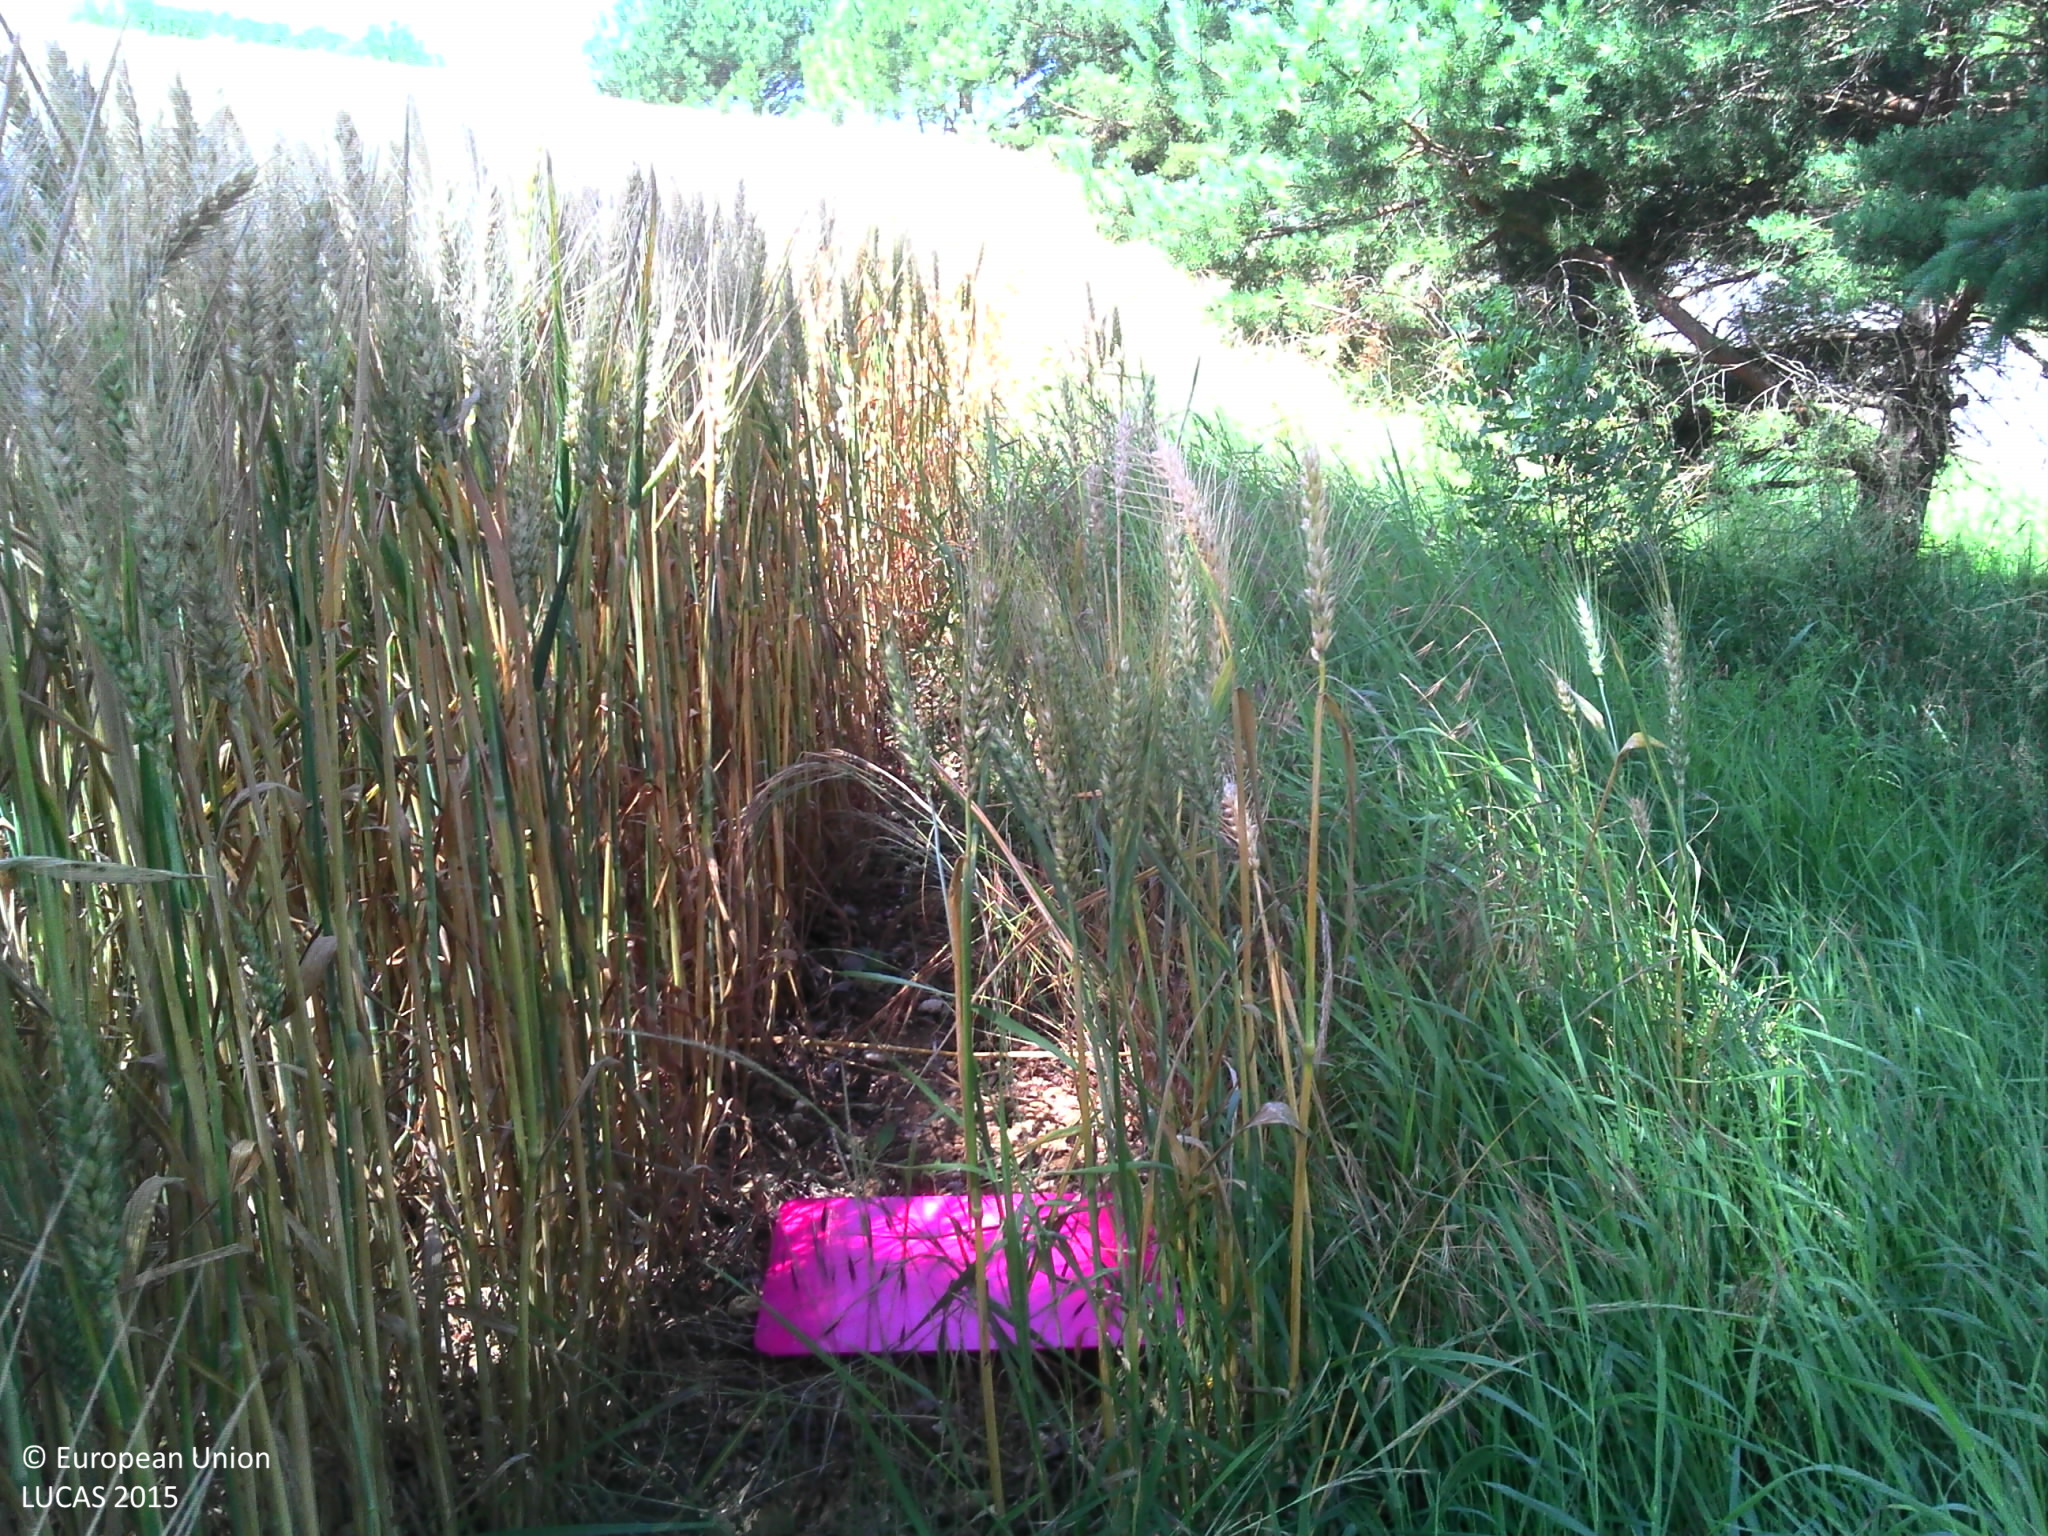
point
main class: Grassland
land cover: Grassland with sparse tree/shrub cover
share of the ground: > 75 %
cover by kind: herbaceous plants 95 %, coniferous forest trees 5 %
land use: Semi-natural and natural areas not in use
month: June
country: FR
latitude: 44.0474
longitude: 2.0777
